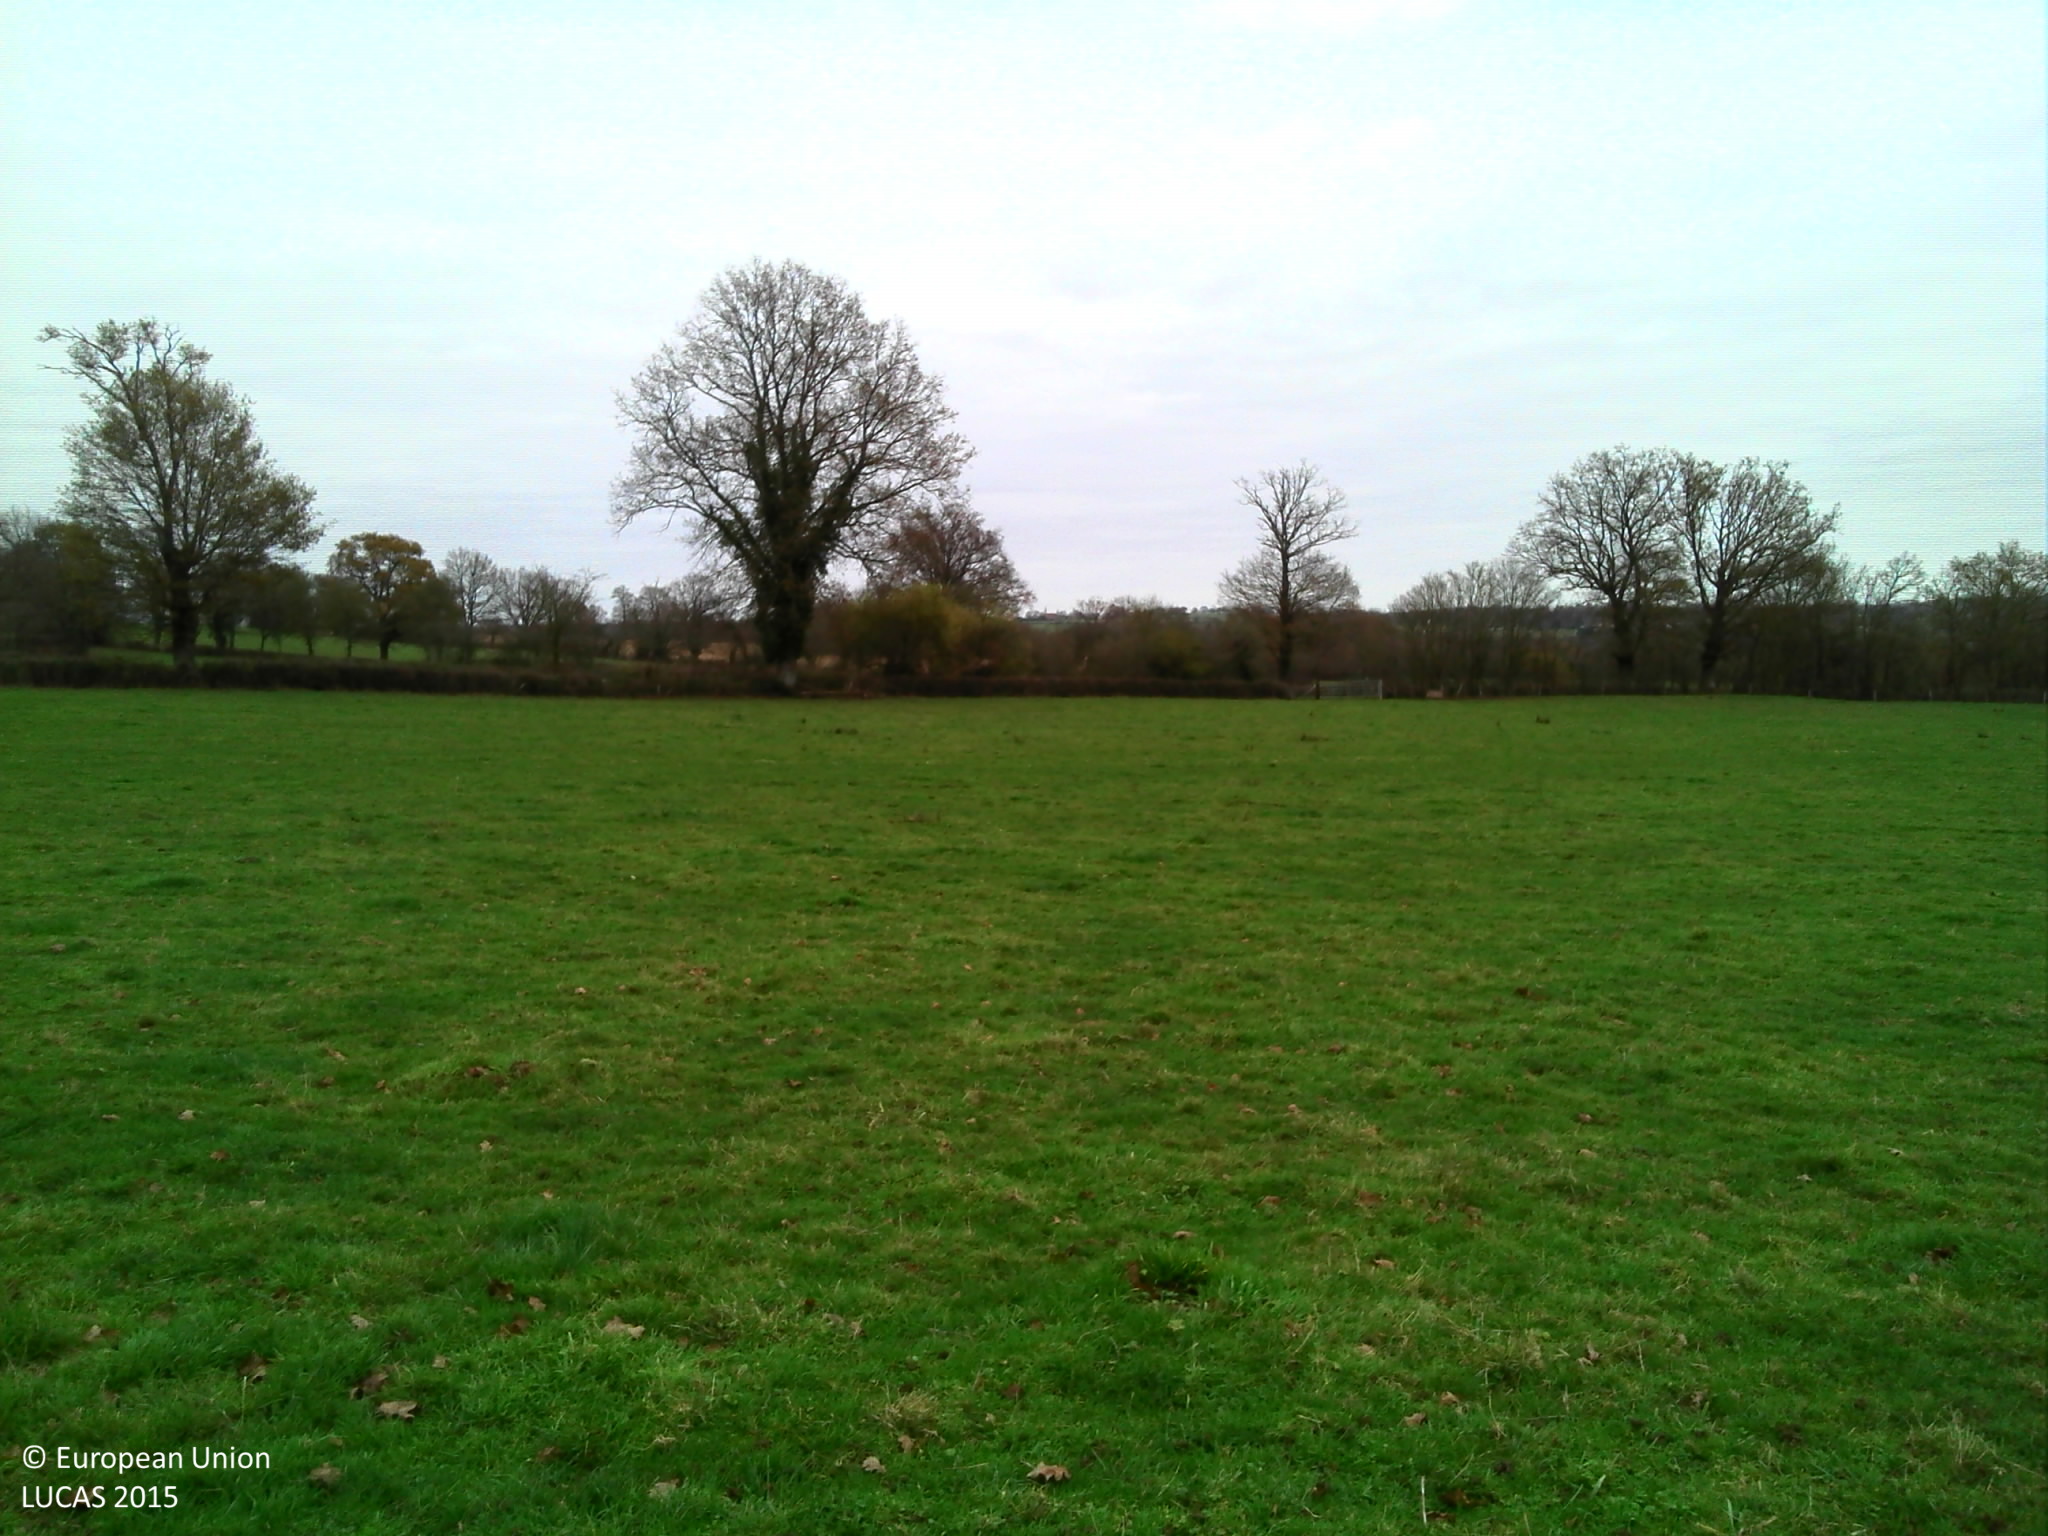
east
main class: Grassland
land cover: Grassland without tree/shrub cover
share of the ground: > 75 %
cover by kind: herbaceous plants 100 %
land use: Agriculture (excluding fallow land and kitchen gardens)
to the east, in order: Grassland without tree/shrub cover; Fences; Managed hedges; Fences; Grassland without tree/shrub cover; Fences; Managed hedges; Grass margins; Fences; Grassland without tree/shrub cover
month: July
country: FR
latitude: 46.5355
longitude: 2.9690
